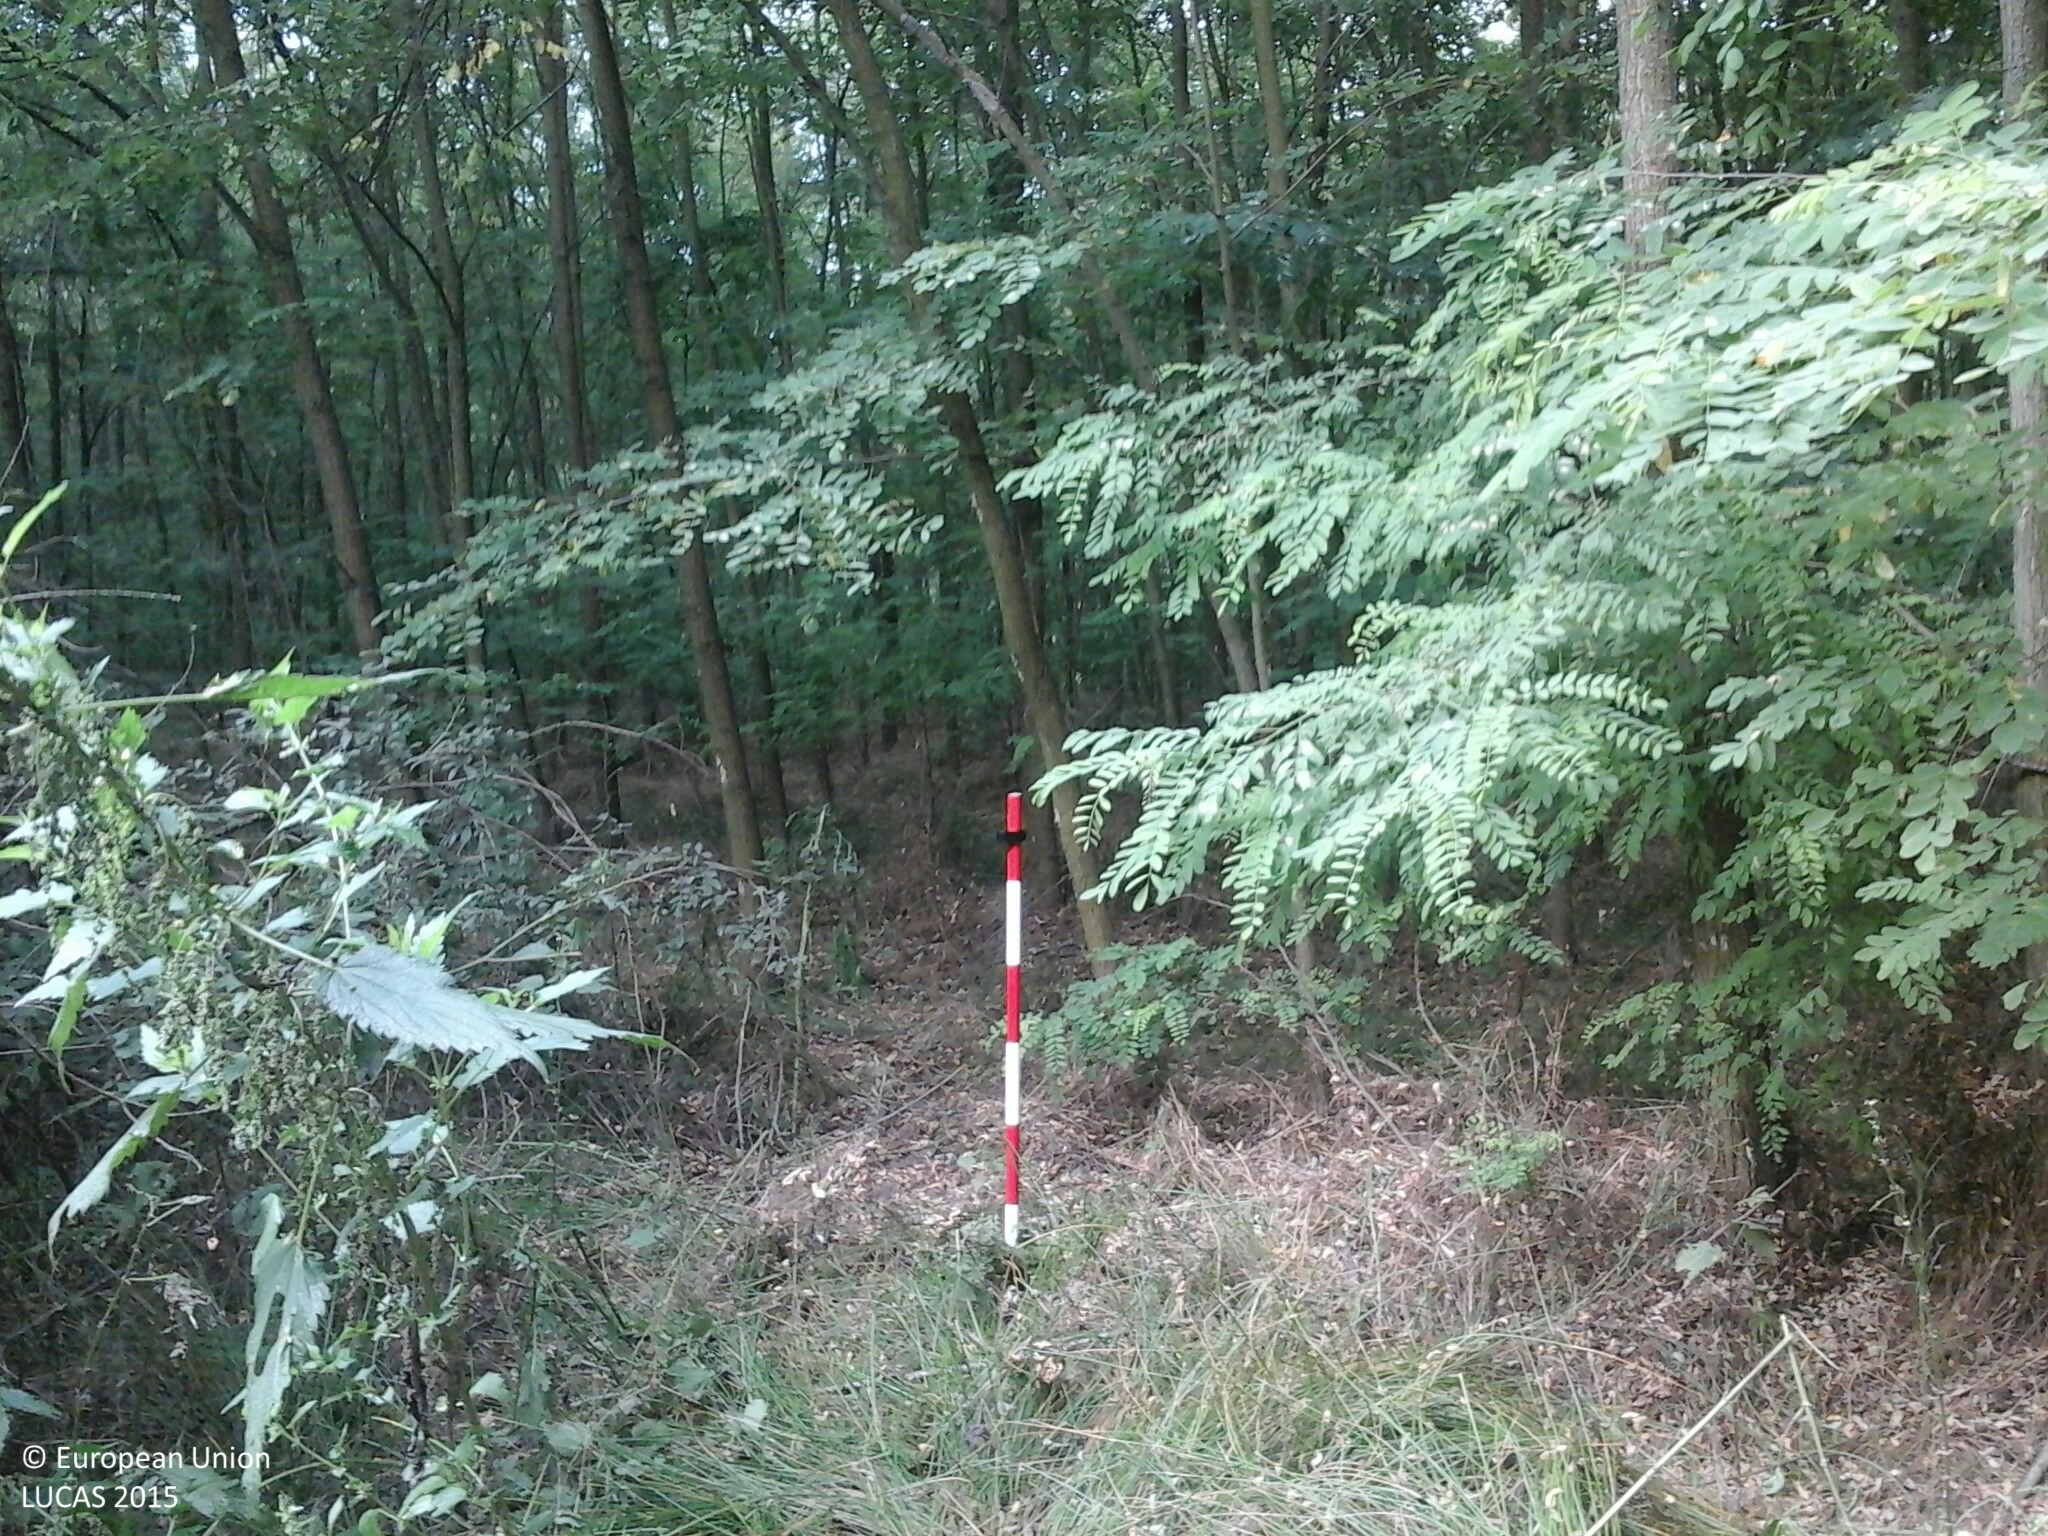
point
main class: Woodland
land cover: Broadleaved woodland
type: exotic forest
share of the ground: > 75 %
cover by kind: broadleaved forest trees 95 %, herbaceous plants 5 %
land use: Forestry
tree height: > 5 m
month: July
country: HU
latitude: 47.7871
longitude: 22.1328
